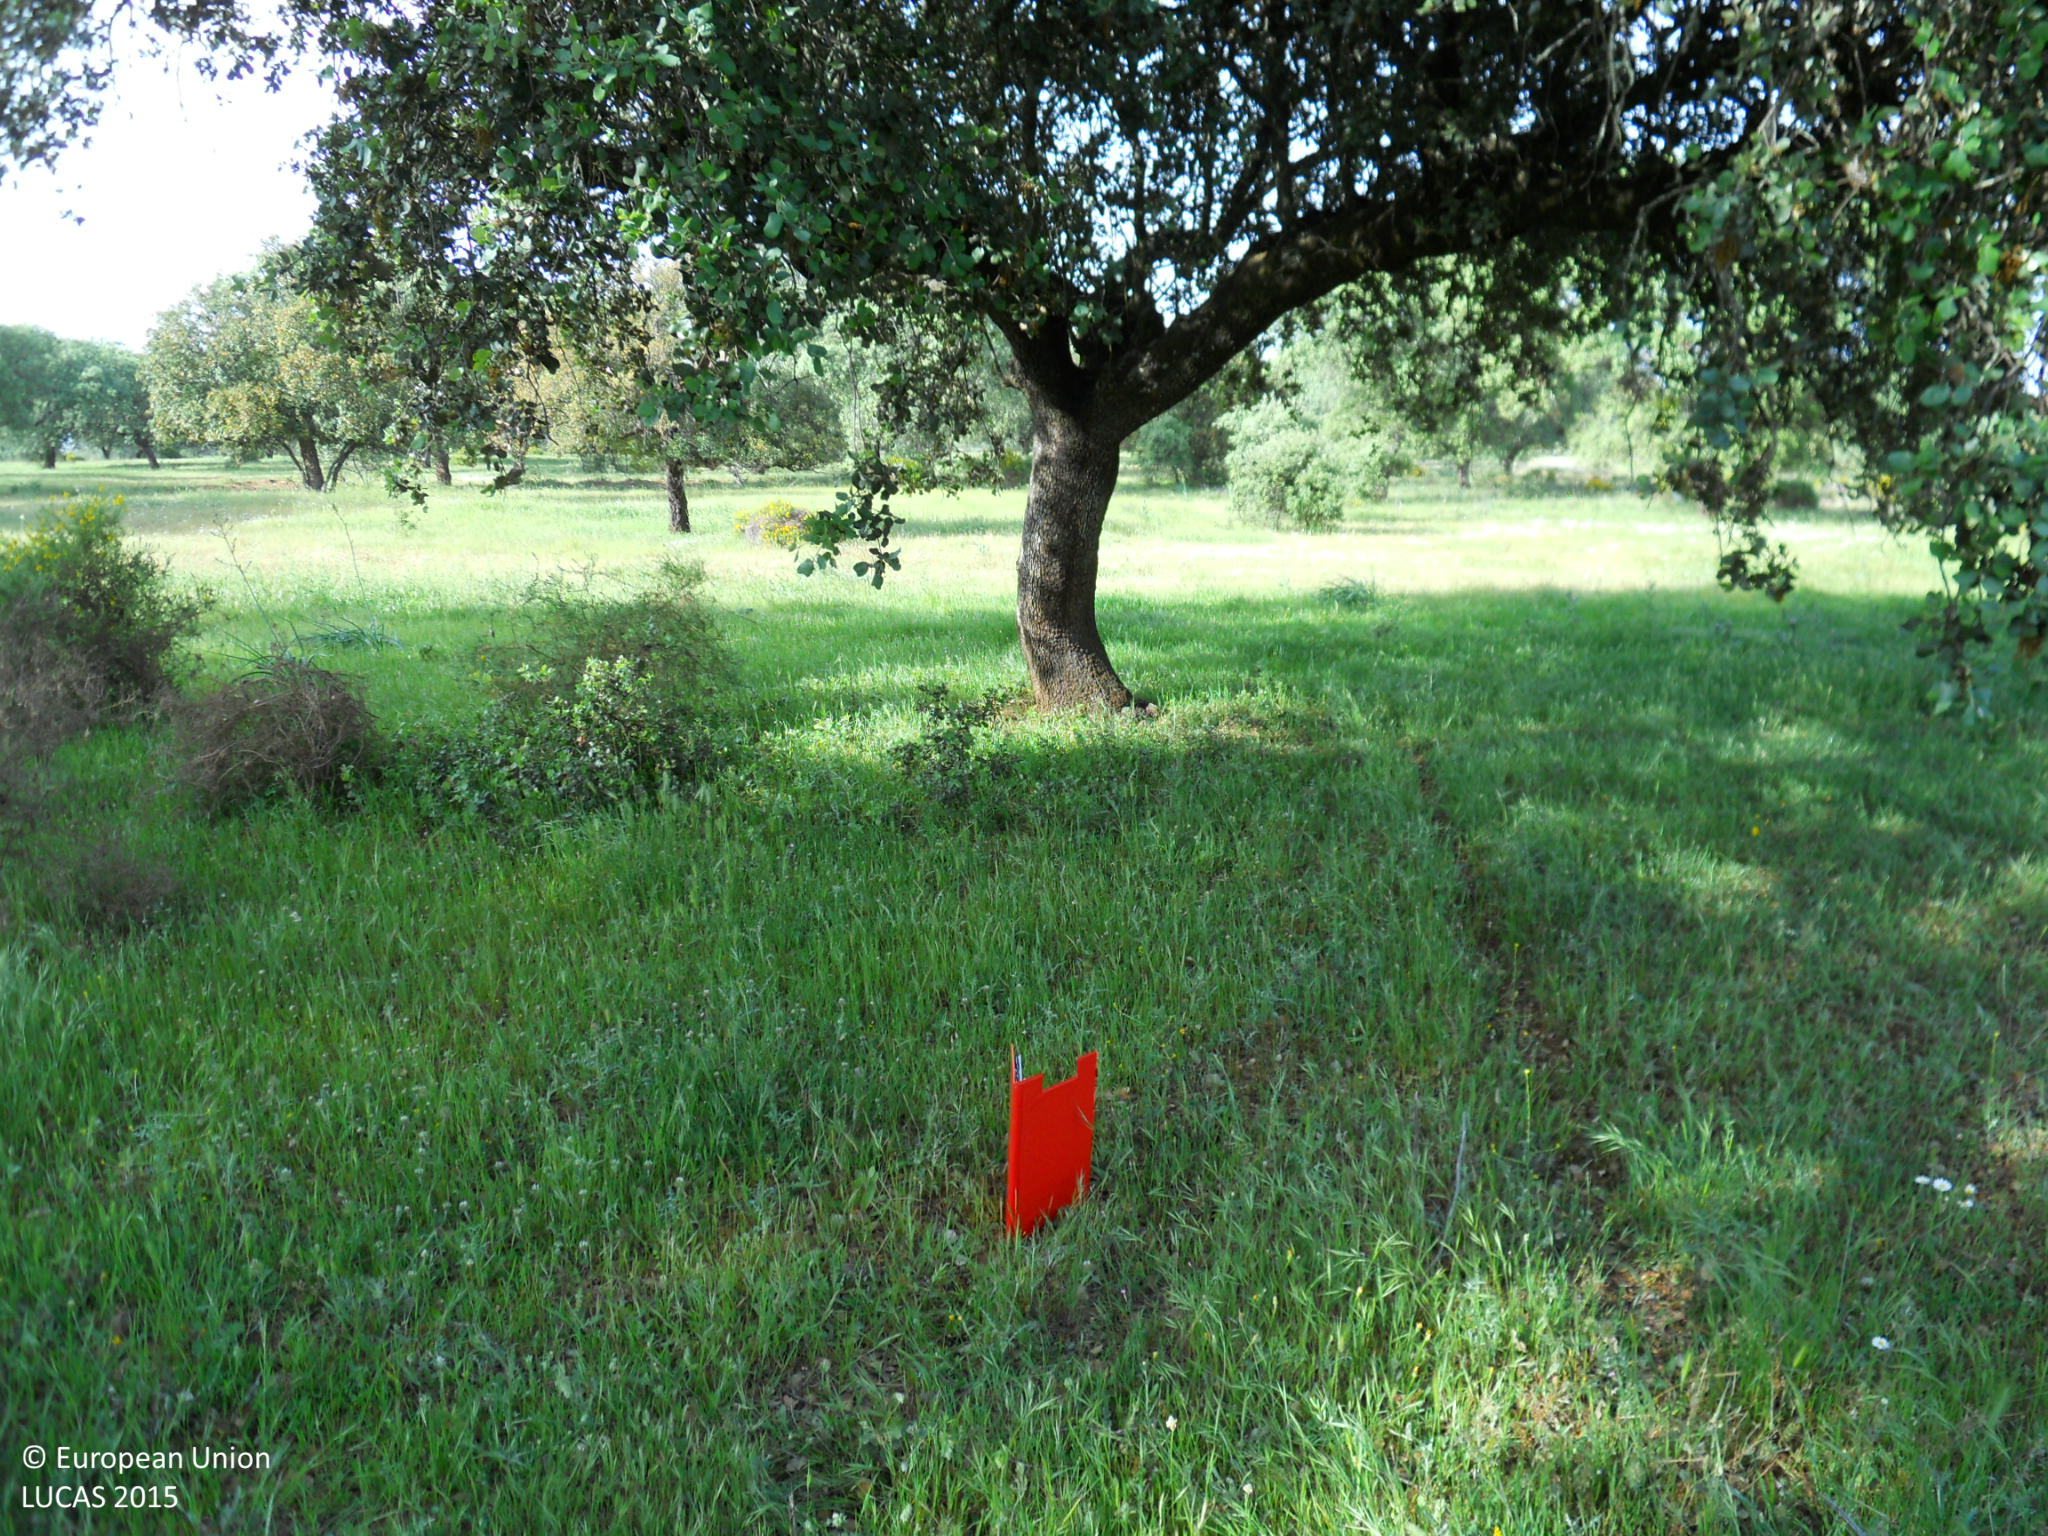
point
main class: Woodland
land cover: Broadleaved woodland
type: broadleaved evergreen forest
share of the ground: 50 - 75 %
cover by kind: broadleaved forest trees 50 %, herbaceous plants 50 %
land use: Forestry
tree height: > 5 m
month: April
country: ES
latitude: 39.0994
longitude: -6.2824
